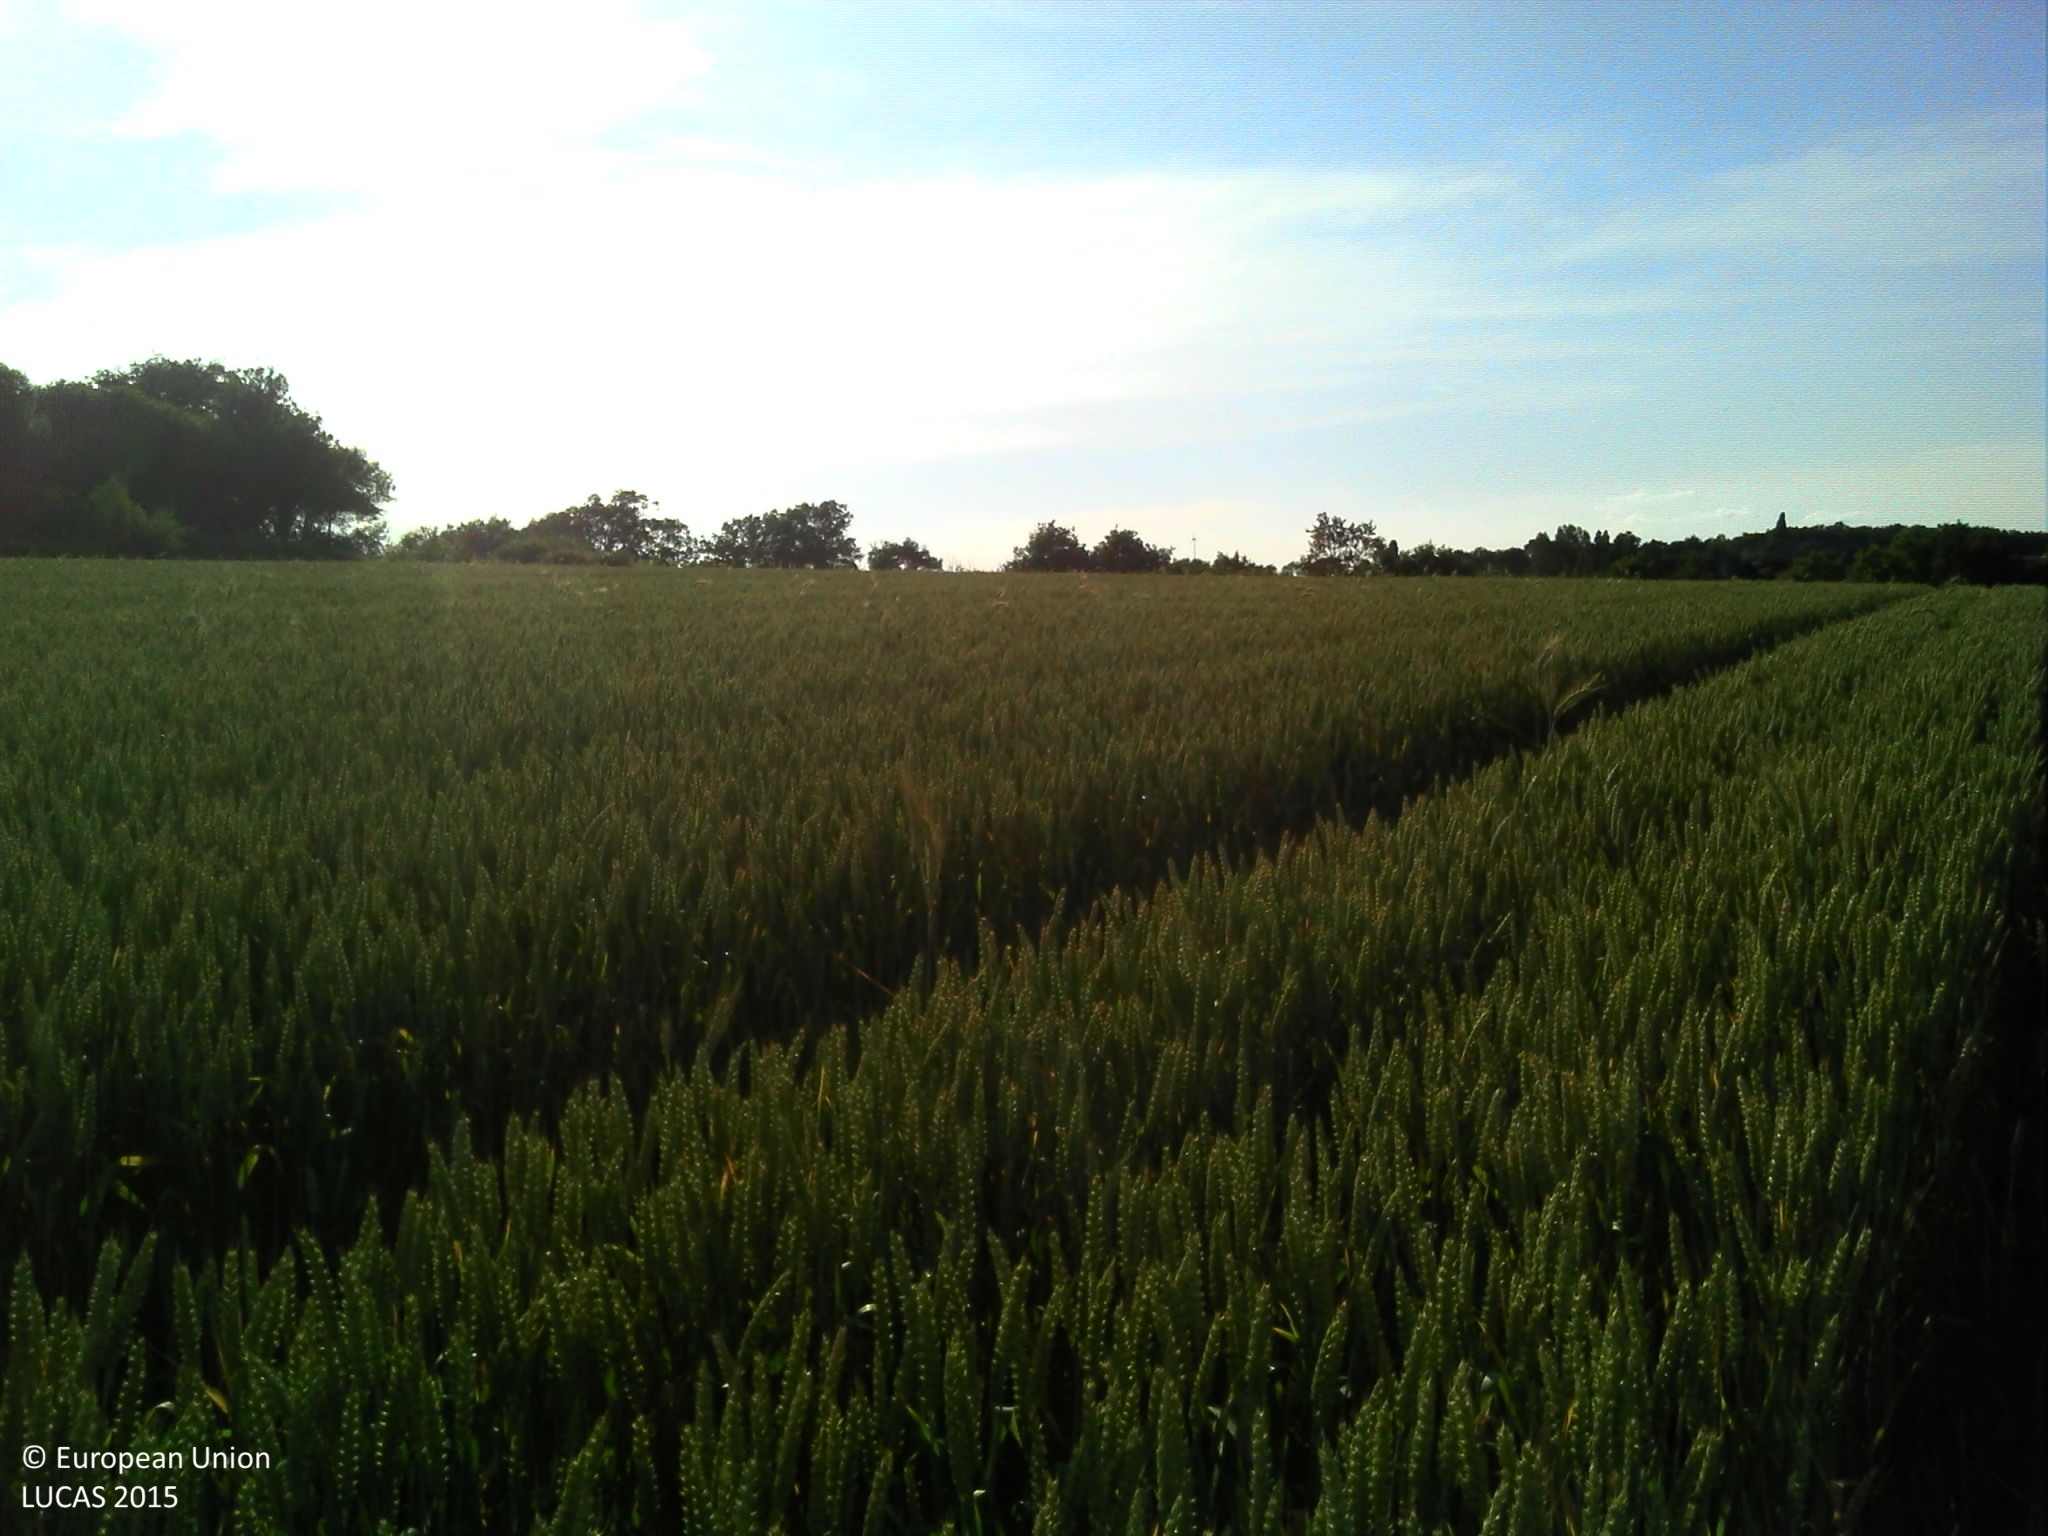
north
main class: Cropland
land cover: Common wheat
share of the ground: > 75 %
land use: Agriculture (excluding fallow land and kitchen gardens)
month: June
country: FR
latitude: 46.9028
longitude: -1.7395
